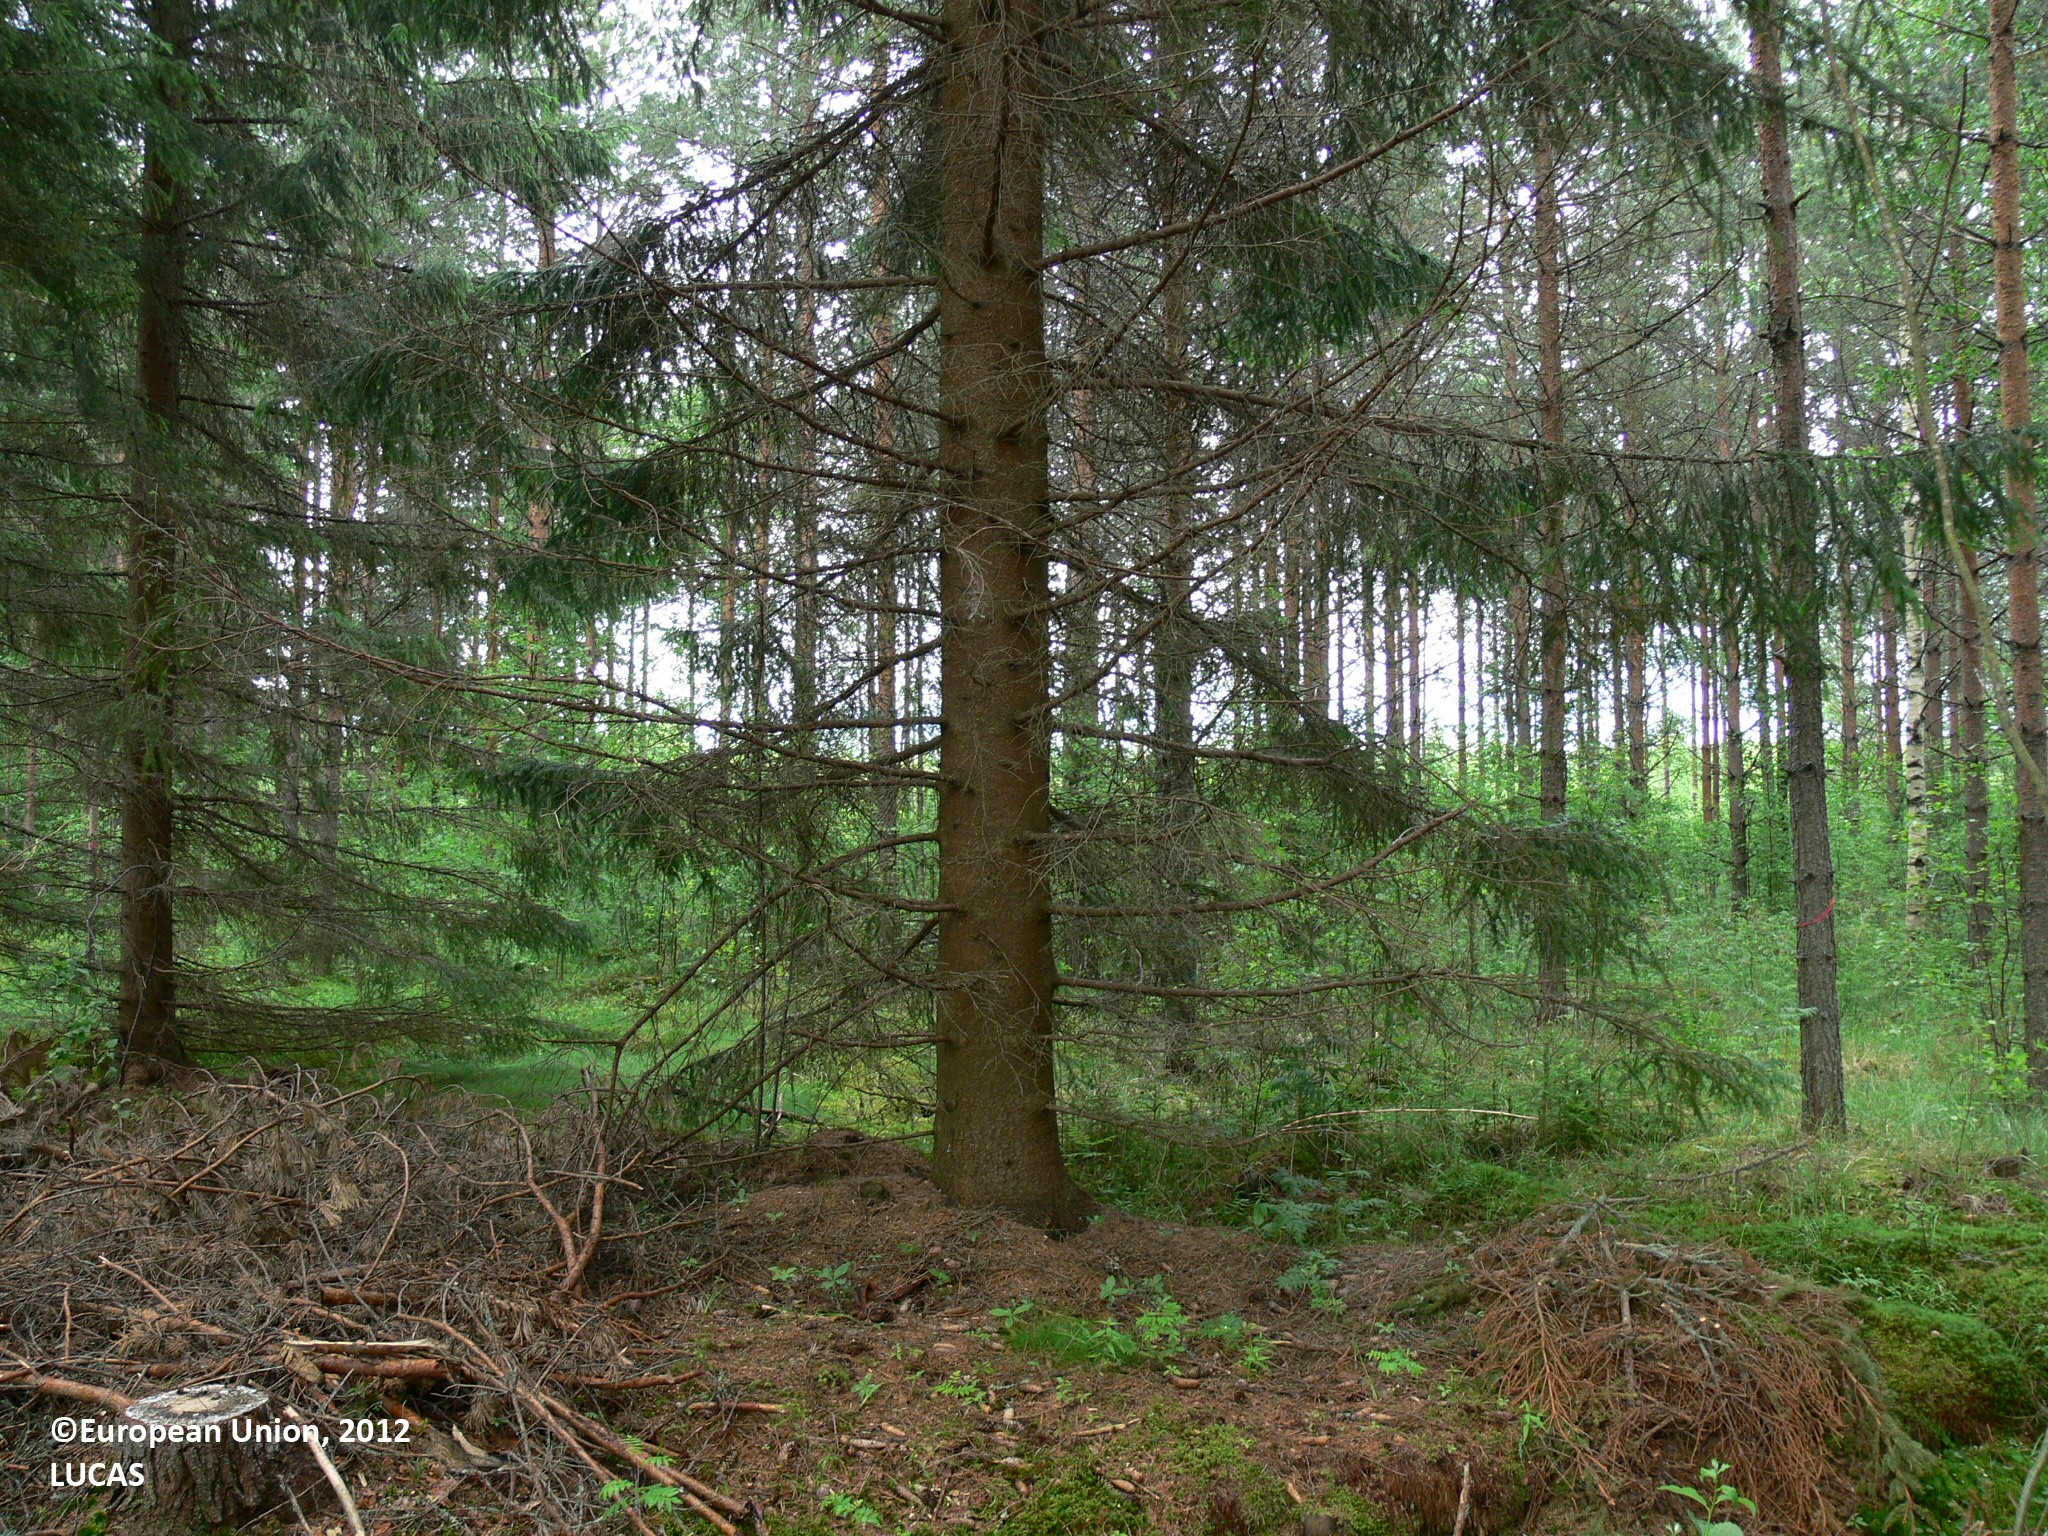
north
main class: Woodland
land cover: Spruce dominated coniferous woodland
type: boreal forest
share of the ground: 50 - 75 %
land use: Forestry
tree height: > 5 m
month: June
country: FI
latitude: 62.5780
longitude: 29.5685
